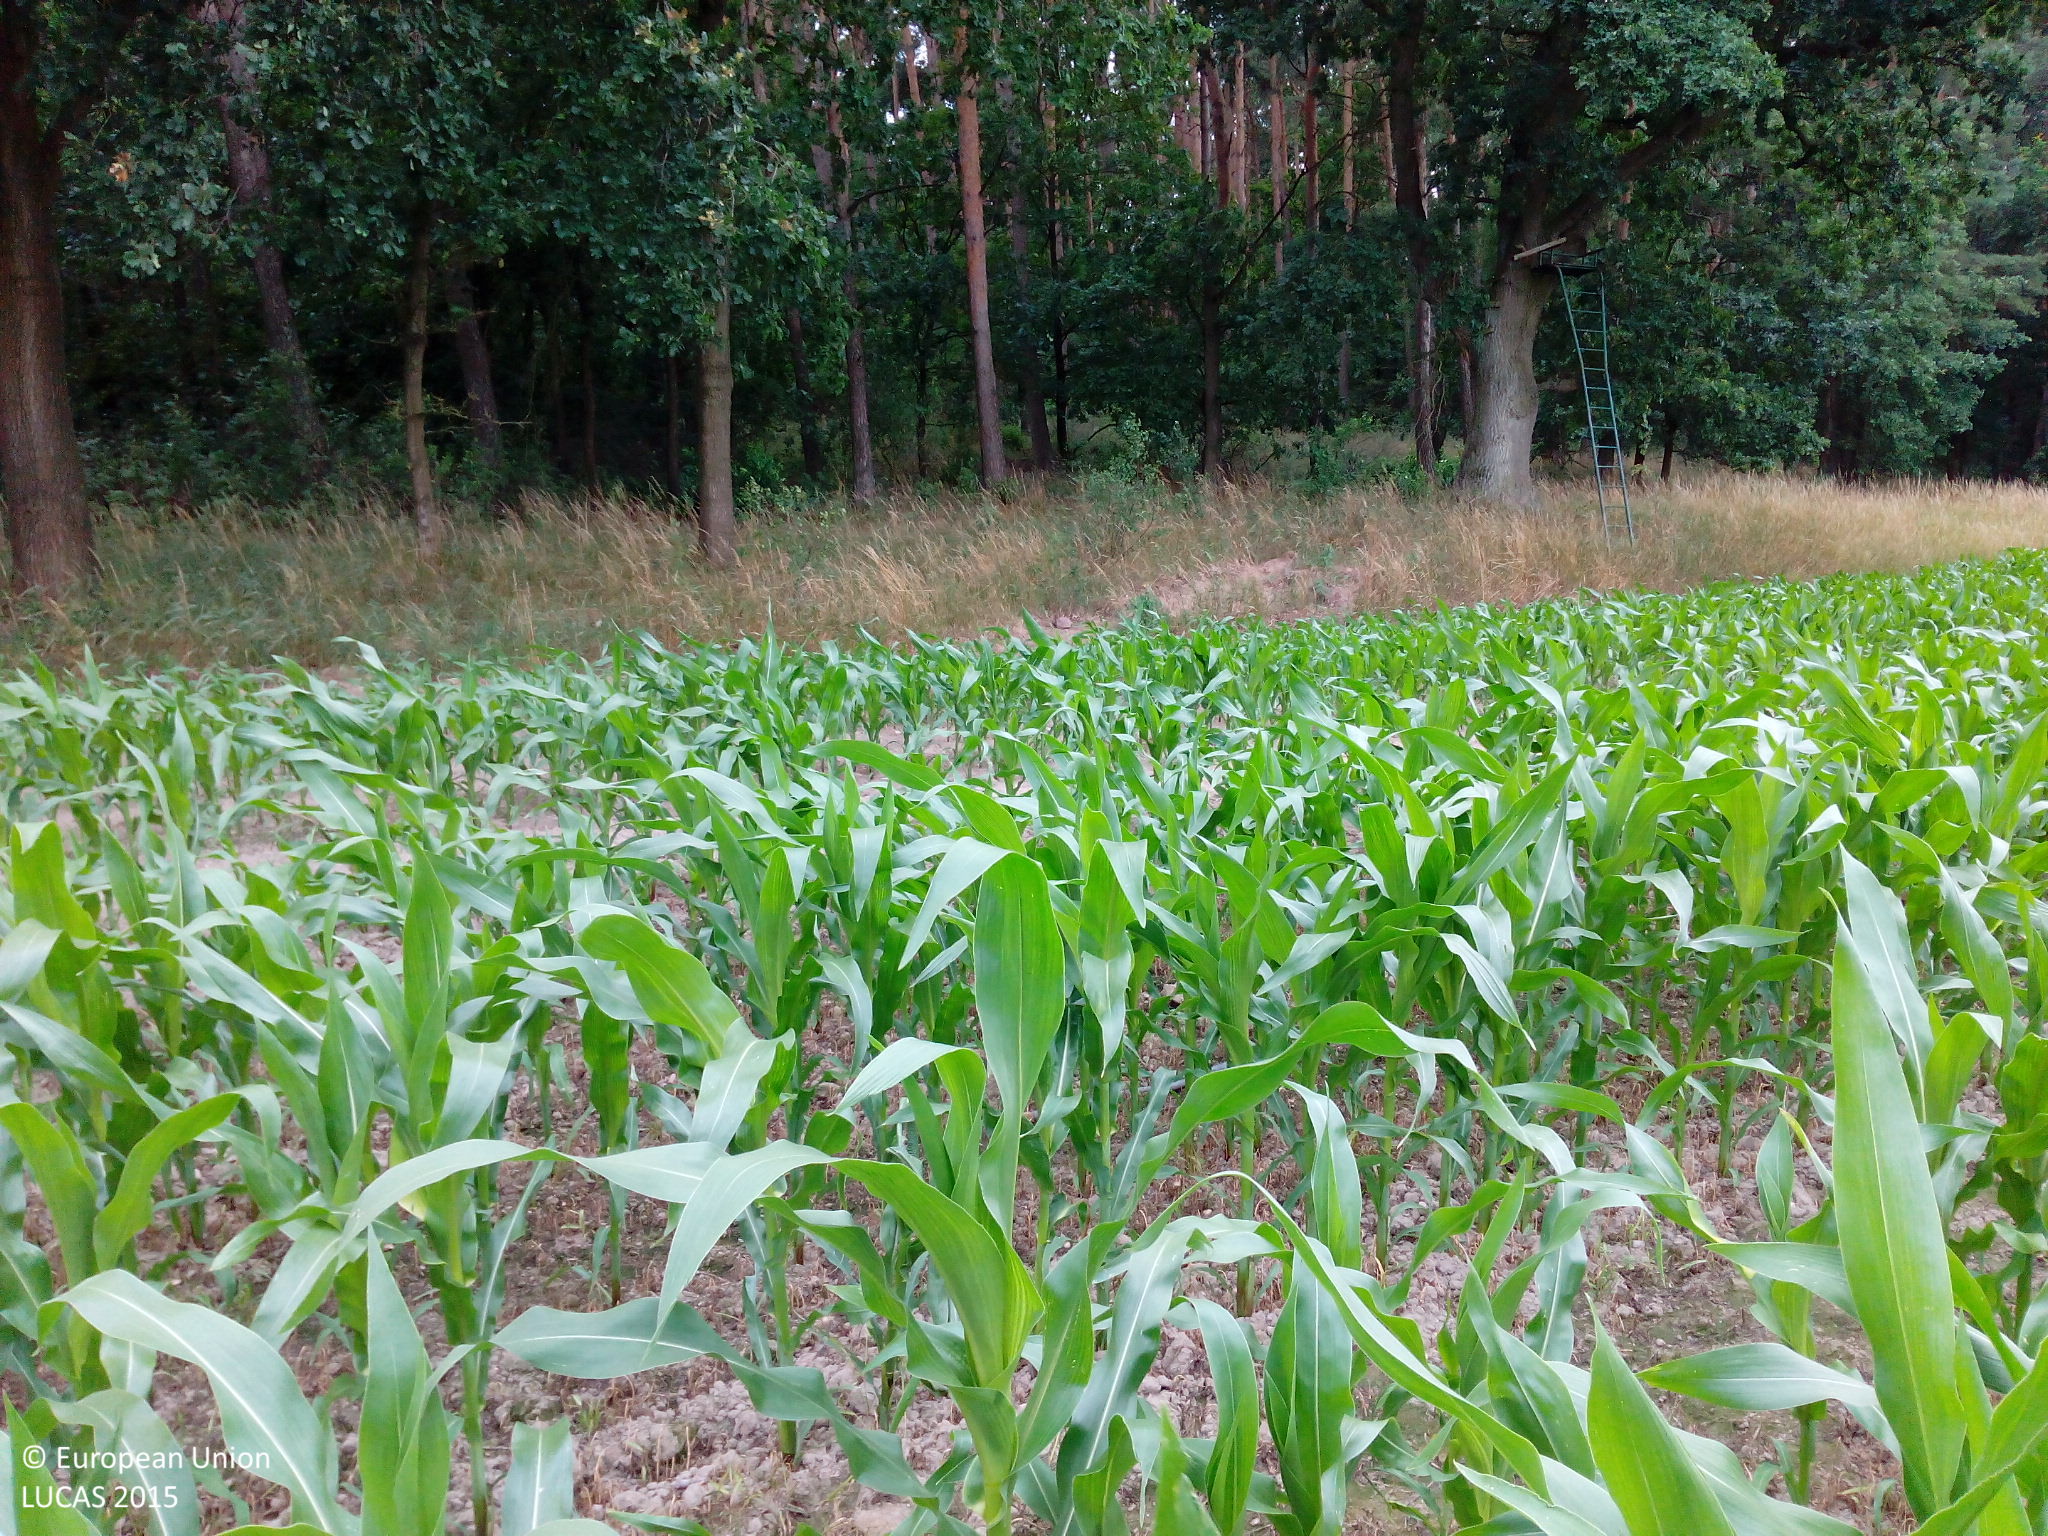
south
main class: Cropland
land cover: Maize
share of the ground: > 75 %
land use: Agriculture (excluding fallow land and kitchen gardens)
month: July
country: DE
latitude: 52.5212
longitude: 14.1423
